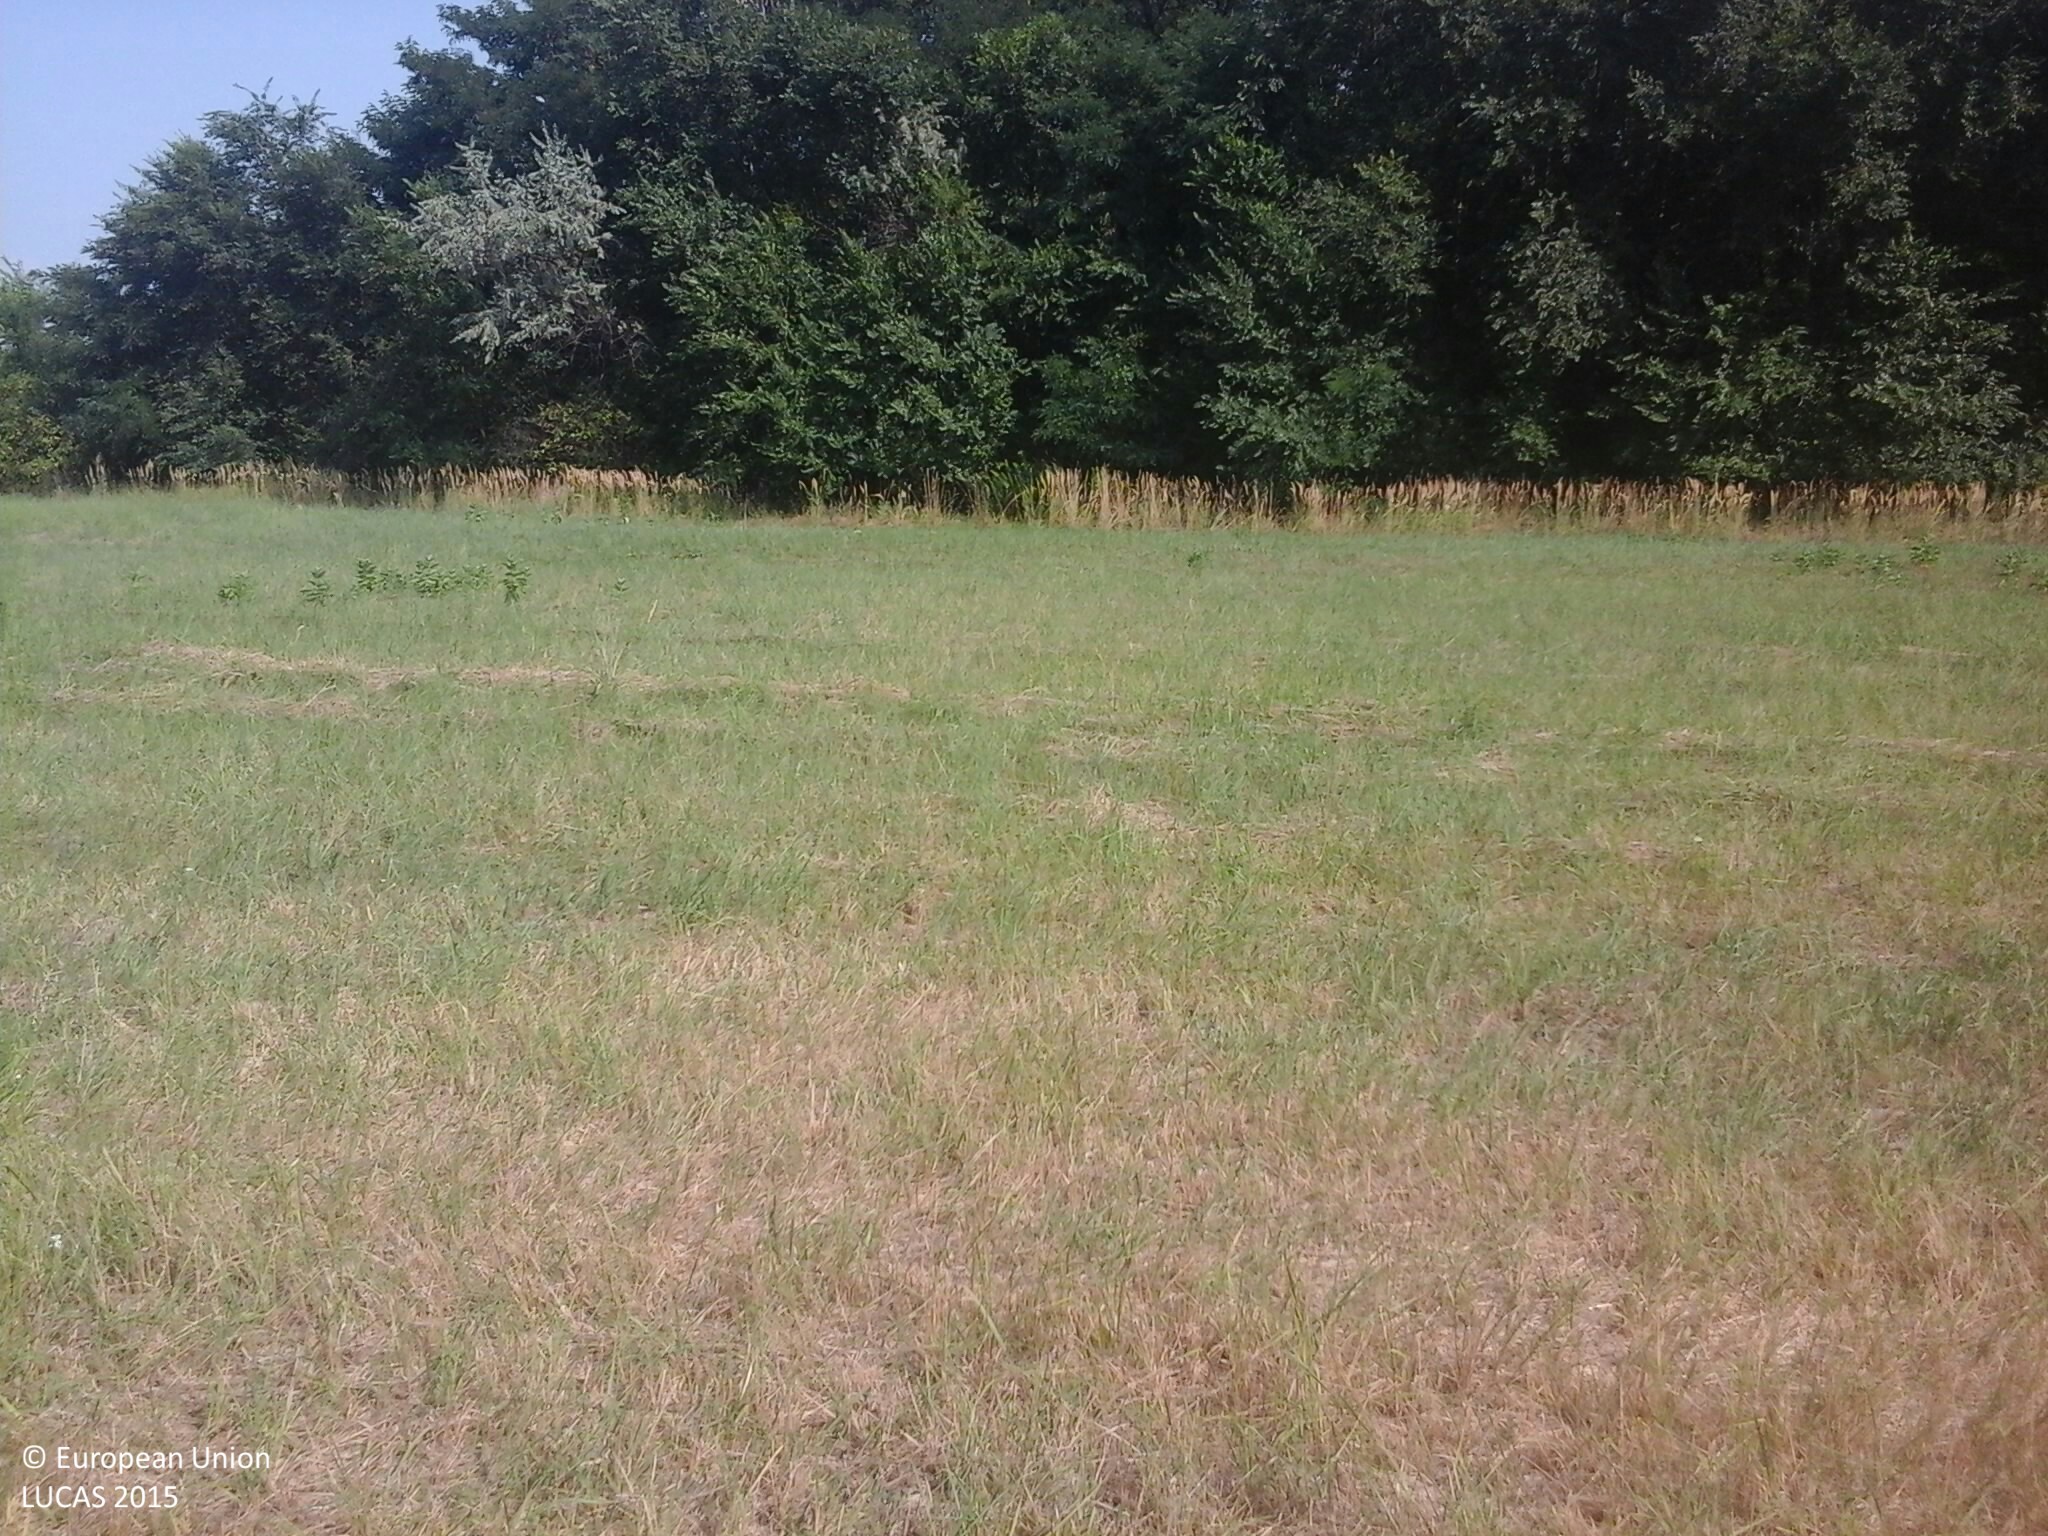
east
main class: Grassland
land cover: Grassland without tree/shrub cover
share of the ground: > 75 %
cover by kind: herbaceous plants 100 %
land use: Agriculture (excluding fallow land and kitchen gardens)
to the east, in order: Grassland without tree/shrub cover; Broadleaved woodland; Tracks; Broadleaved woodland; Fences; Grassland without tree/shrub cover; Ditches and canals; Grass margins; Paved roads, cycling and walking lanes; Grass margins; Paved roads, cycling and walking lanes; Grass margins; Ditches and canals; Grass margins; Shrubland without tree cover; Fences; Other non-permanent industrial crops
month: August
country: HU
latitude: 47.4144
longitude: 19.2837
